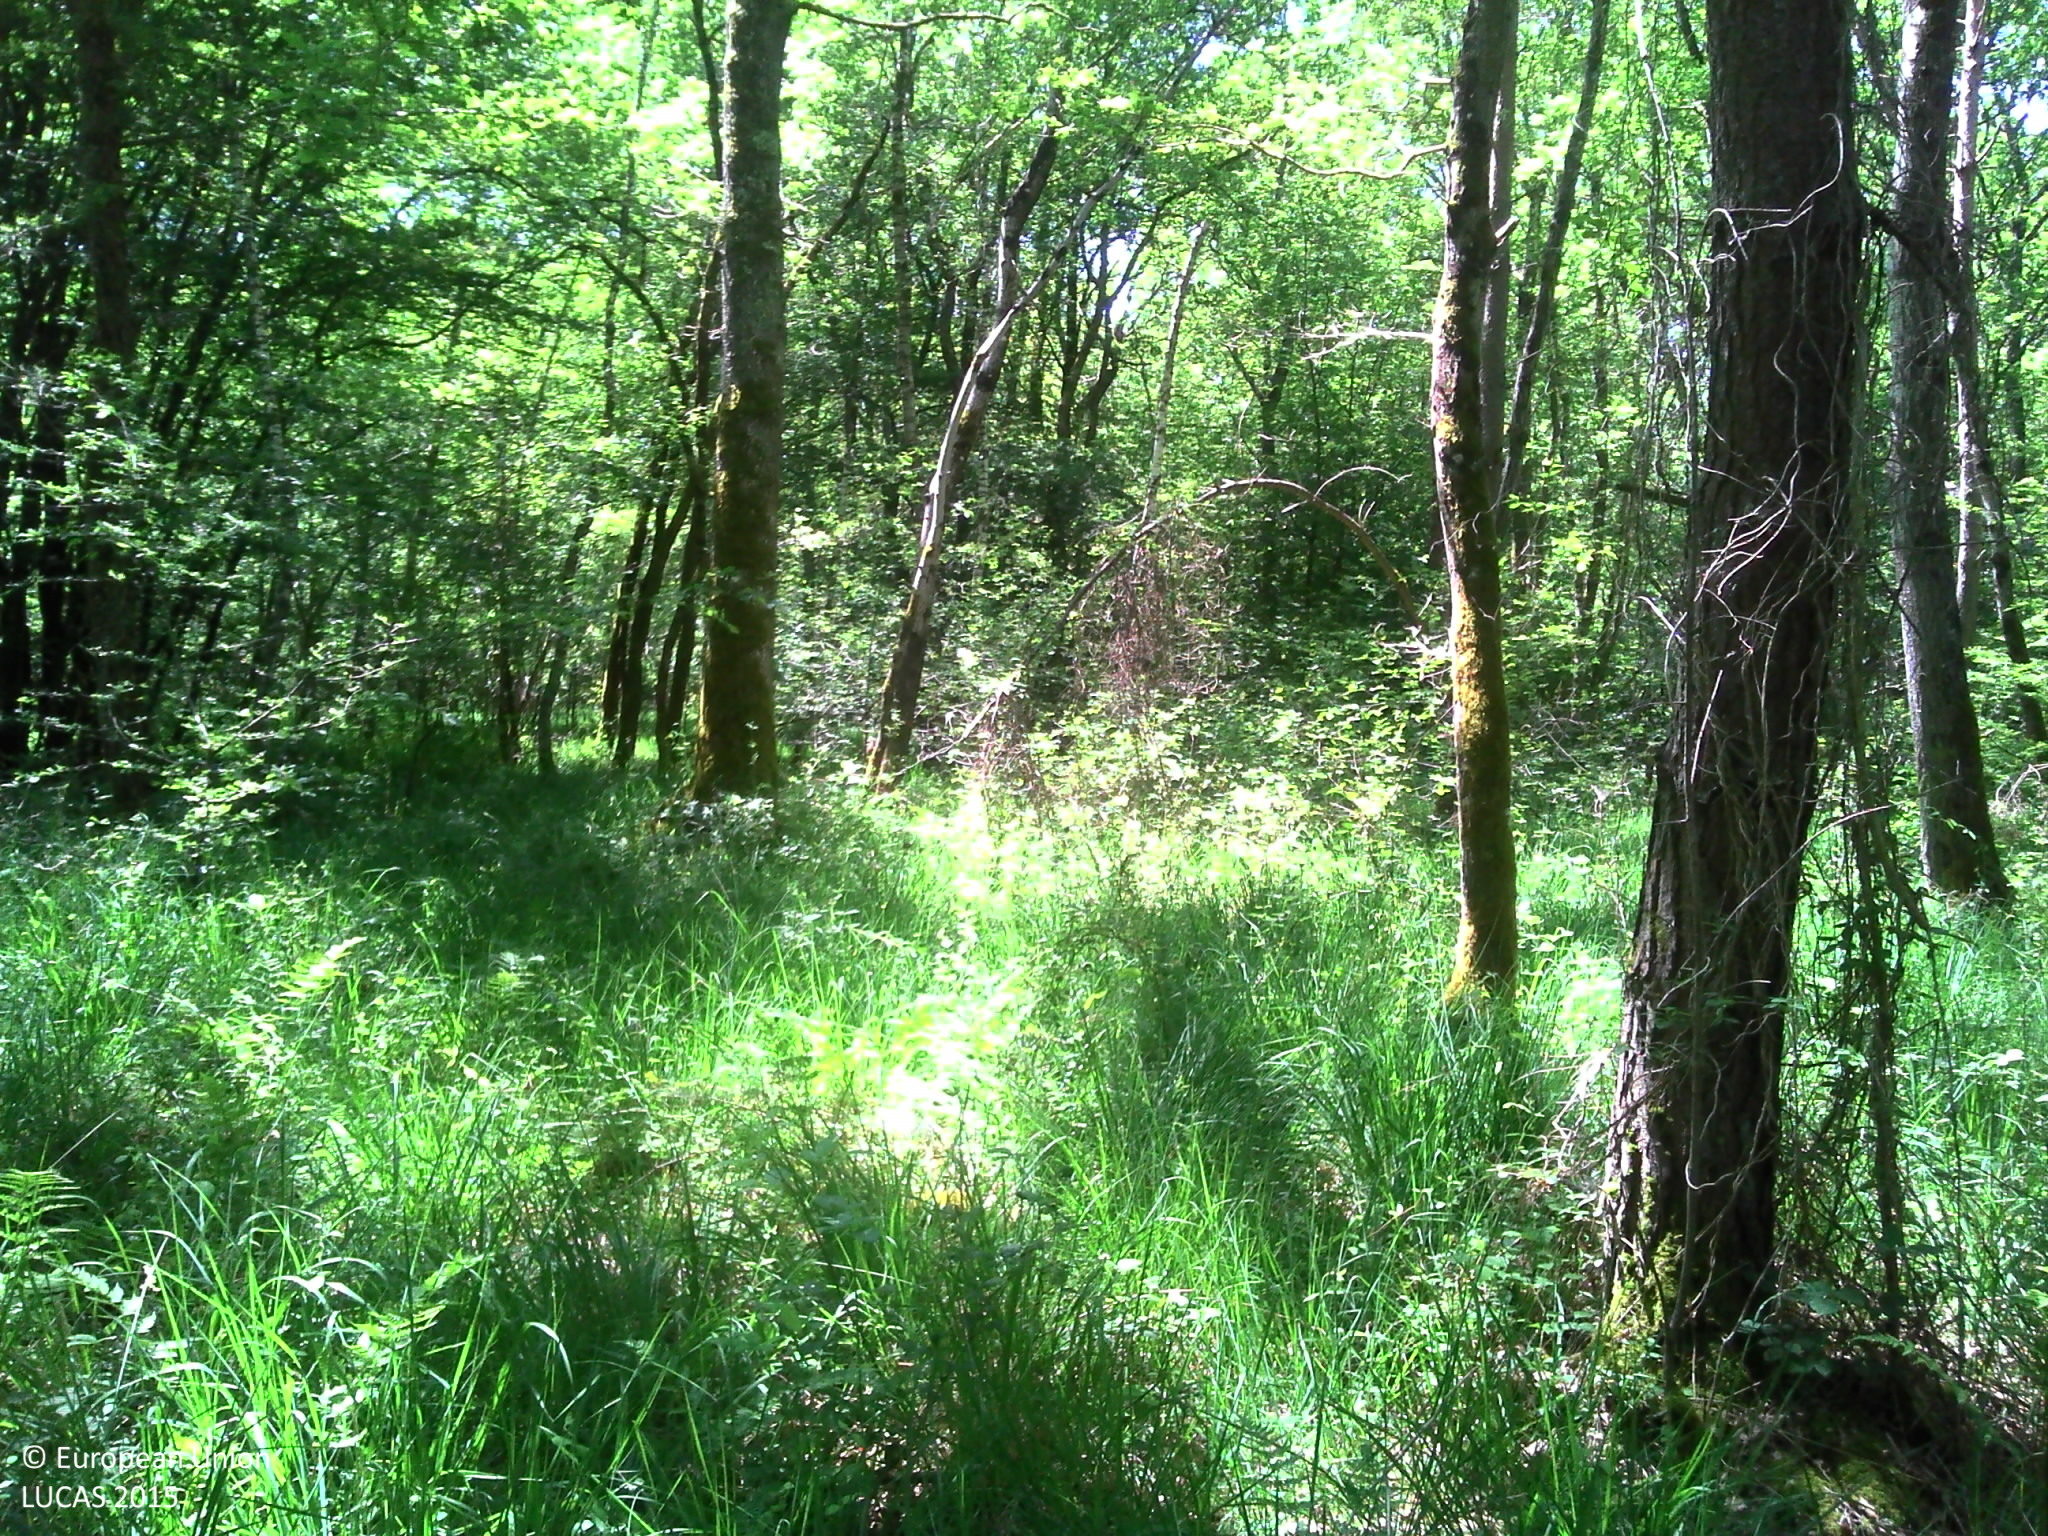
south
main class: Woodland
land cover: Broadleaved woodland
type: thermophilous deciduous forest
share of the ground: > 75 %
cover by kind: broadleaved forest trees 80 %, herbaceous plants 20 %
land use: Forestry
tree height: > 5 m
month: June
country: FR
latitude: 46.6201
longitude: 4.7648
